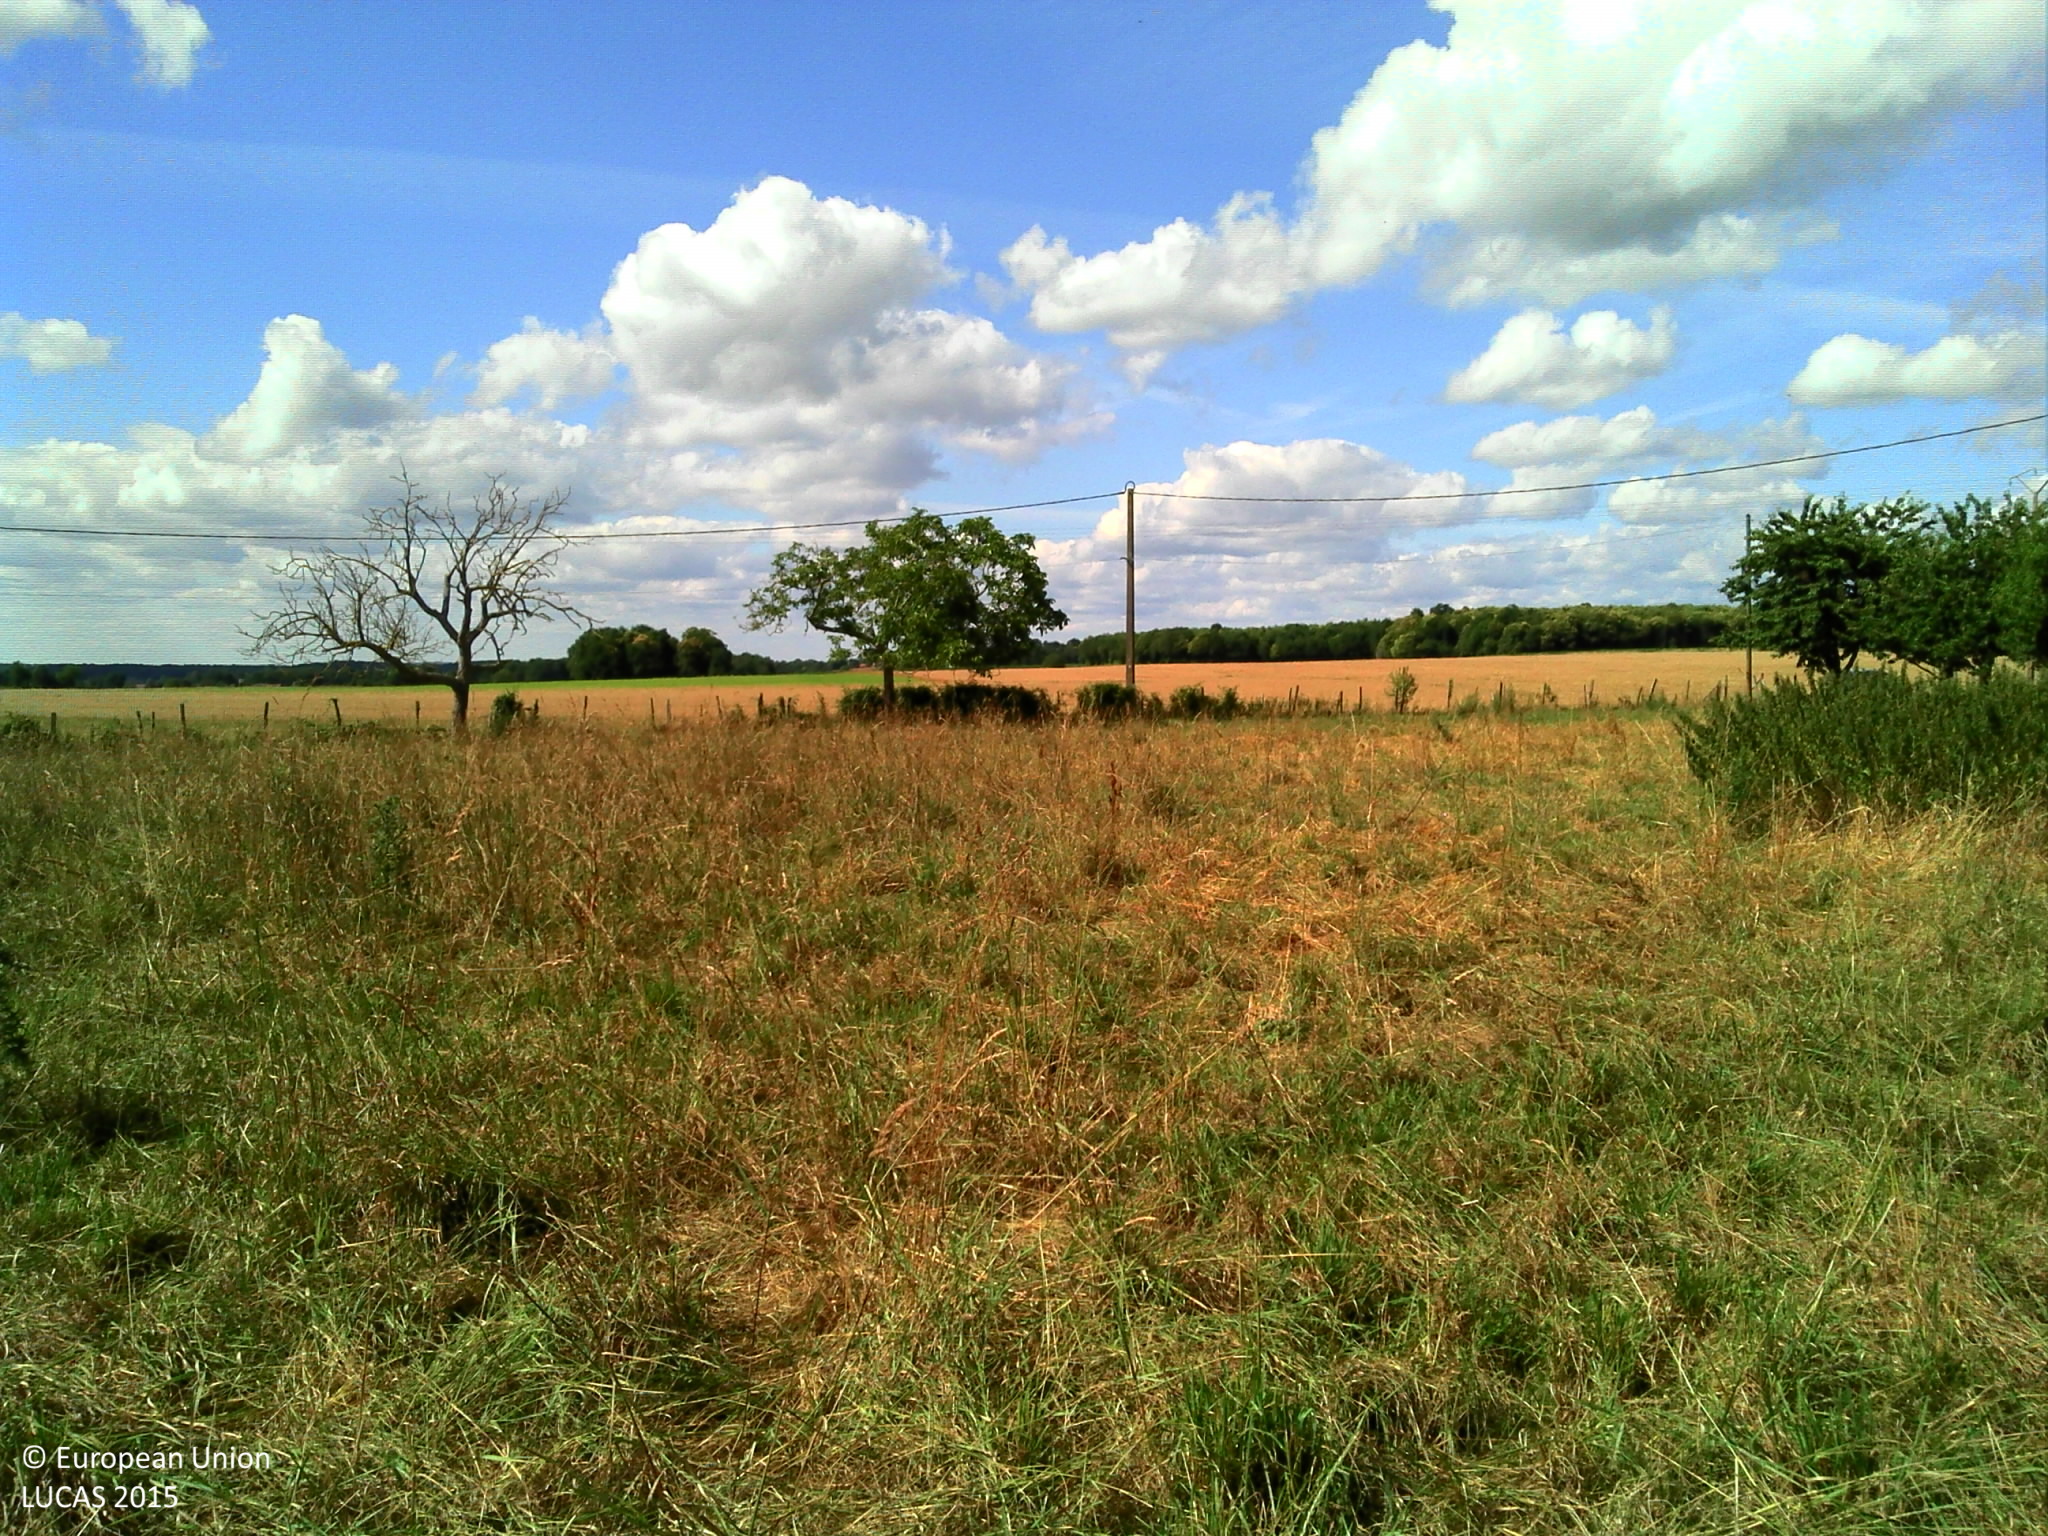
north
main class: Grassland
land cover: Grassland without tree/shrub cover
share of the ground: > 75 %
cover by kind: herbaceous plants 100 %
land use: Agriculture (excluding fallow land and kitchen gardens)
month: June
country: FR
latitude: 45.7047
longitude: 0.4423
